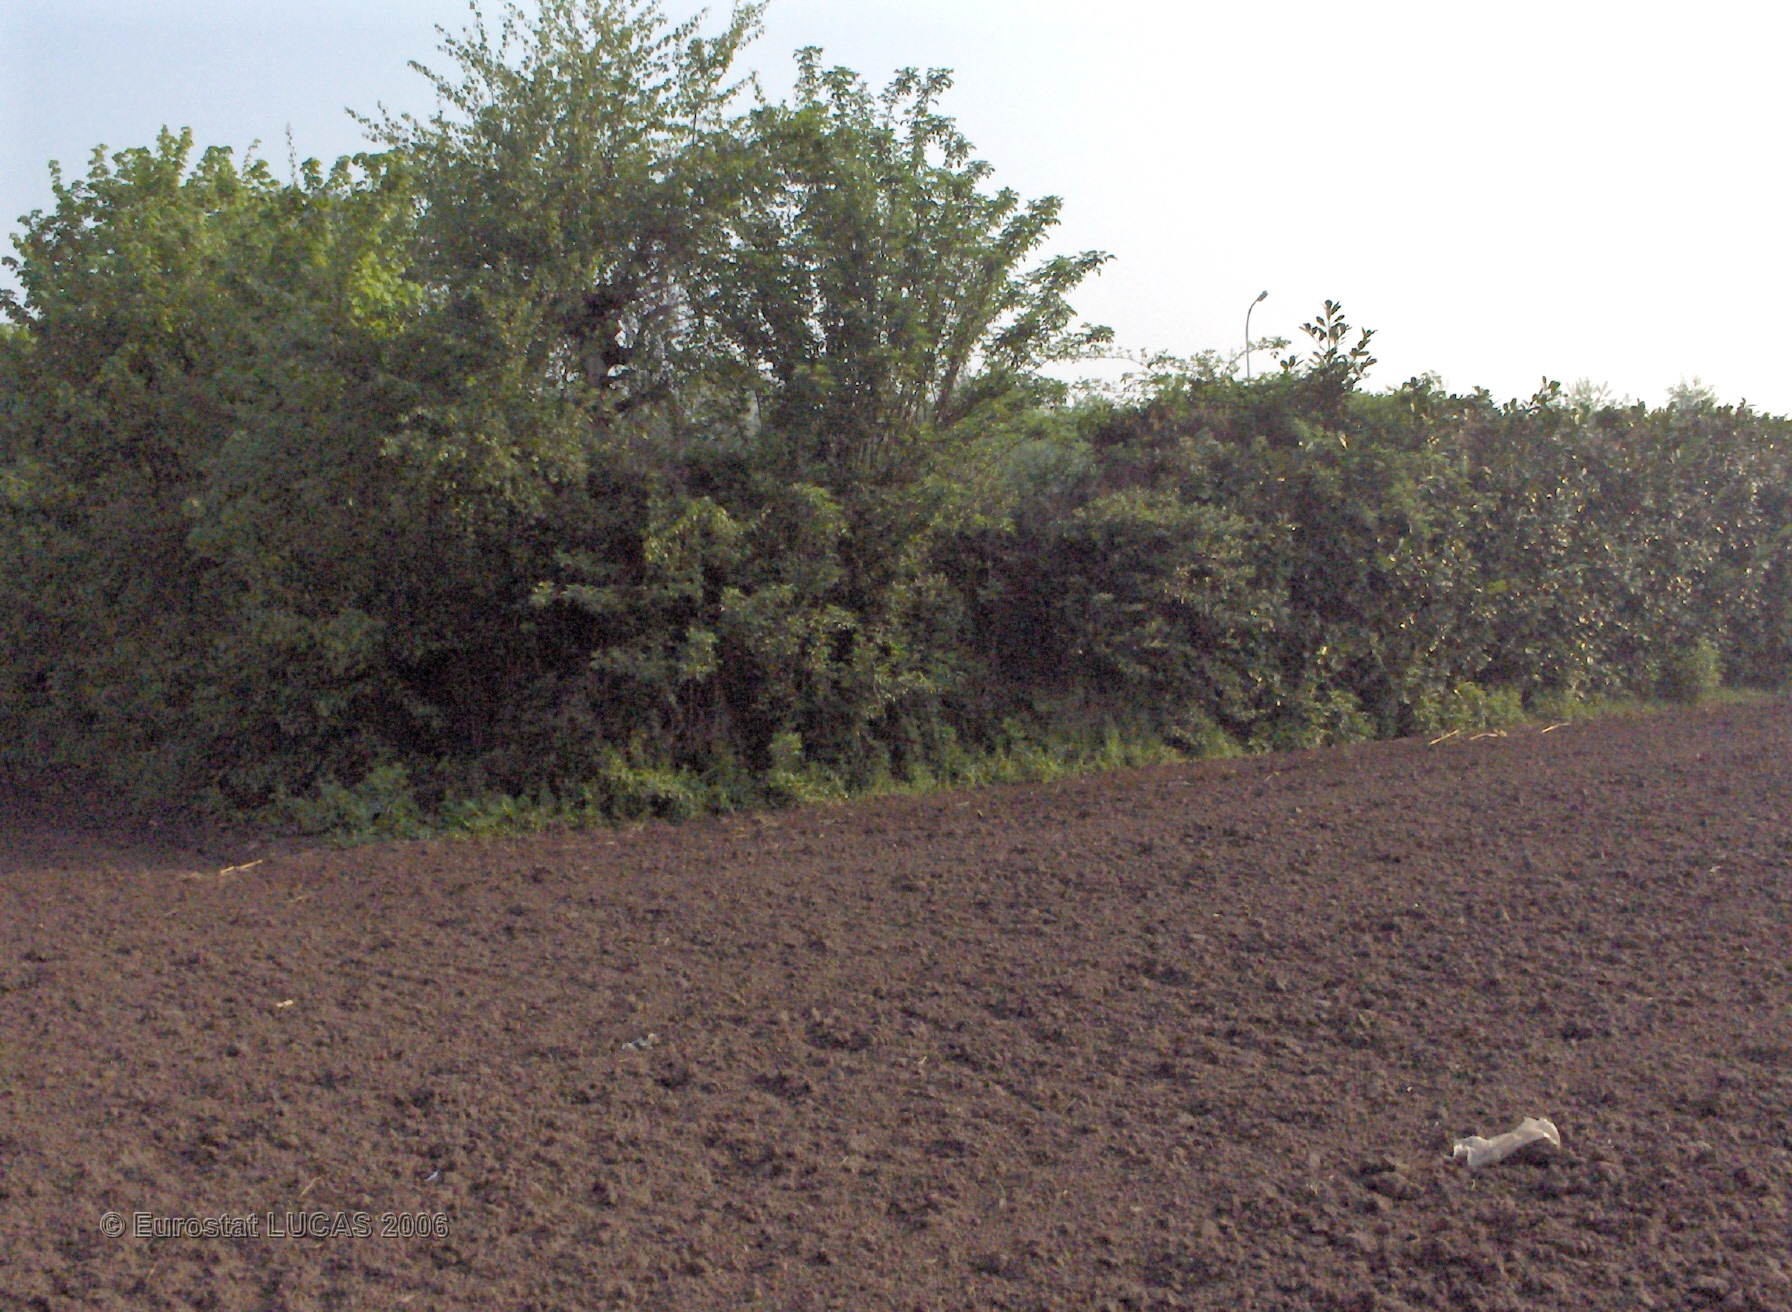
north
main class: Cropland
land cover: Maize
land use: Agriculture (excluding fallow land and kitchen gardens)
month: May
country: BE
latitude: 51.0940
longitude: 4.4412
